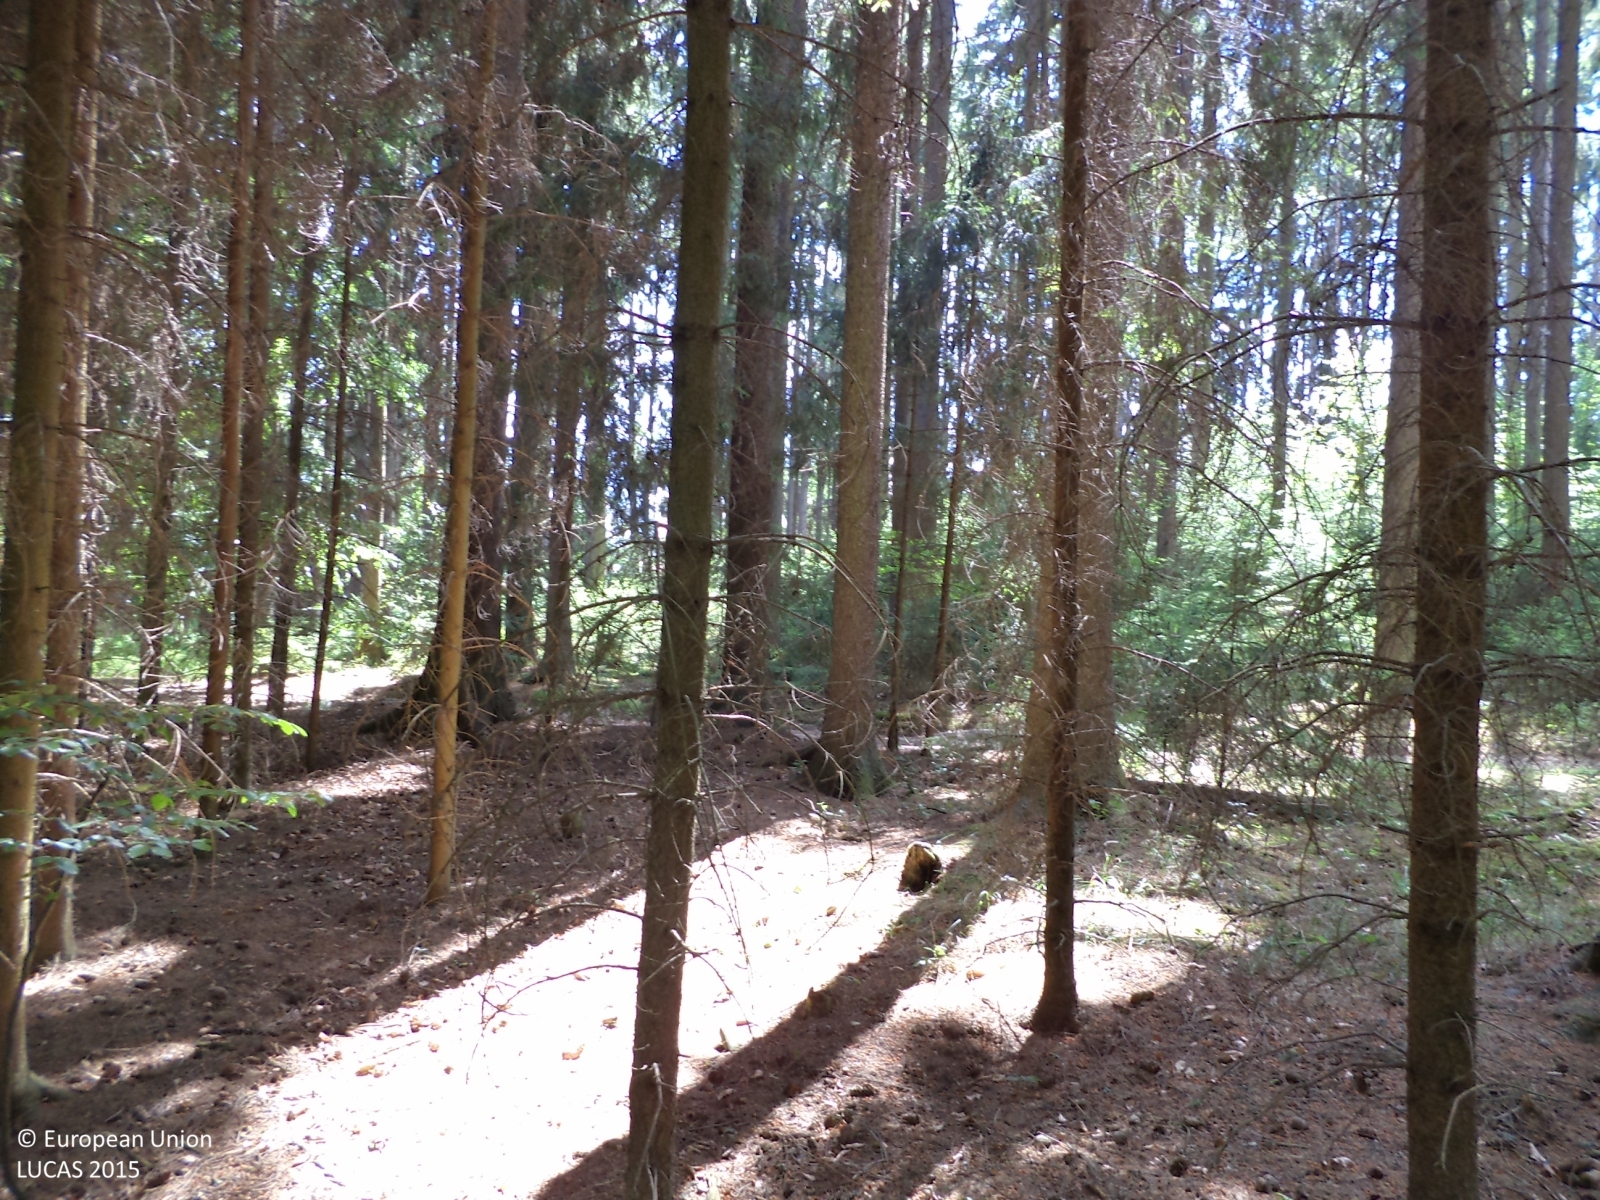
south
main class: Woodland
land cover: Spruce dominated coniferous woodland
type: hemiboreal forest and nemoral coniferous forest and mixed broadleaved-coniferous forest
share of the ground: > 75 %
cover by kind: coniferous forest trees 90 %, herbaceous plants 10 %
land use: Forestry
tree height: > 5 m
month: July
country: CZ
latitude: 49.5139
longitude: 14.6287
